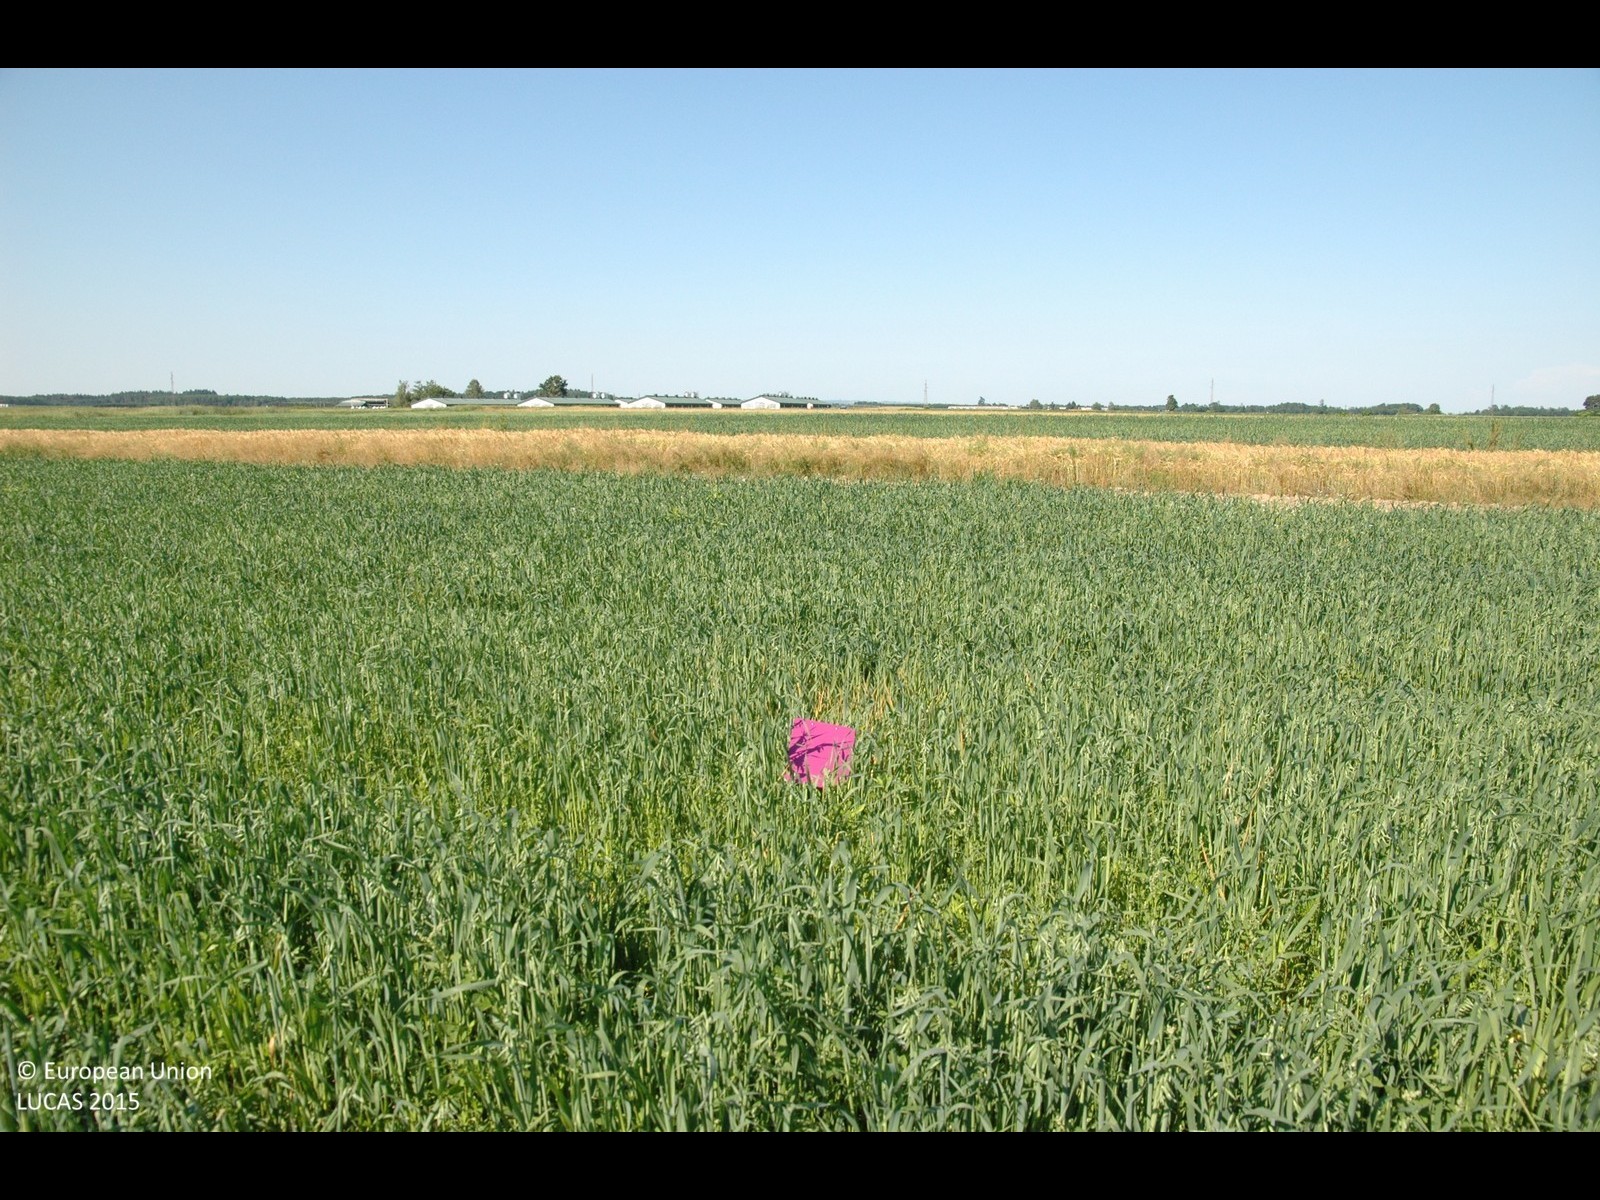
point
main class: Cropland
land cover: Oats
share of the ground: > 75 %
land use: Agriculture (excluding fallow land and kitchen gardens)
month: June
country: HR
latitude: 46.3162
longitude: 16.1944
